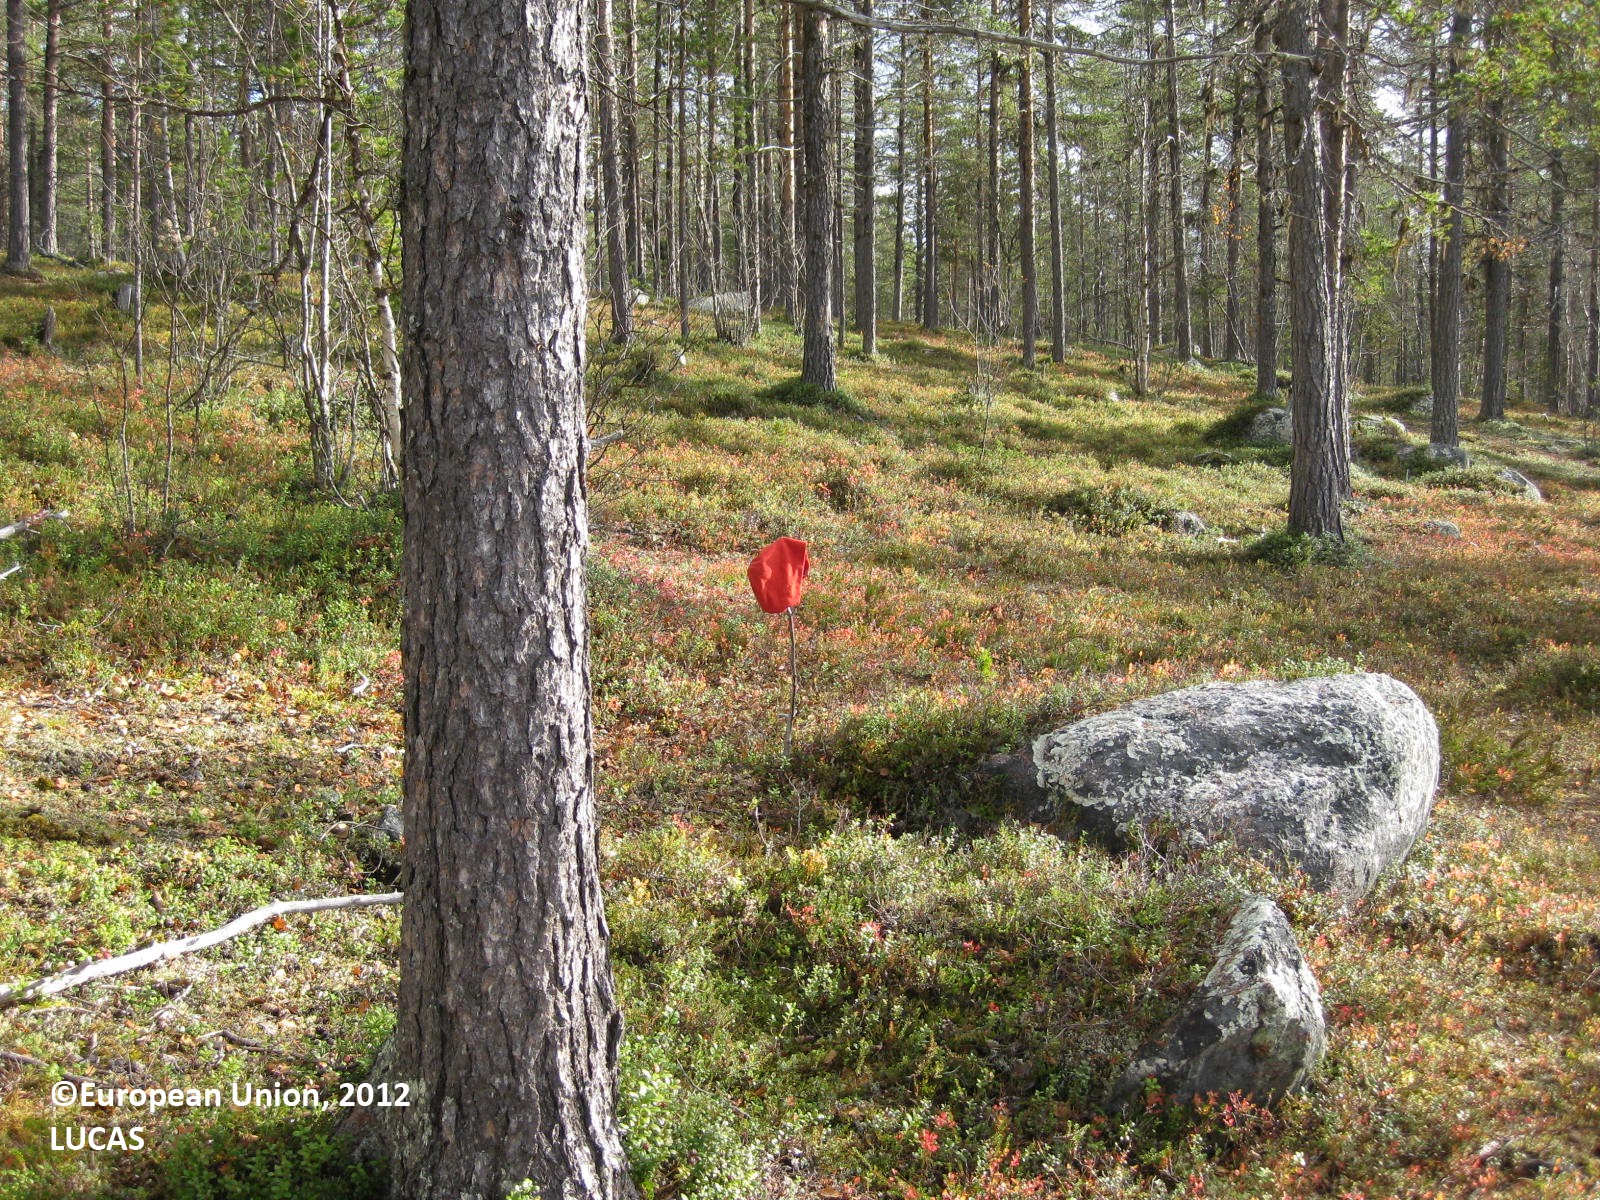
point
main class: Woodland
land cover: Pine dominated coniferous woodland
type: boreal forest
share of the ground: 50 - 75 %
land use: Forestry
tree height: > 5 m
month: September
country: FI
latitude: 68.0544
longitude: 23.7505
